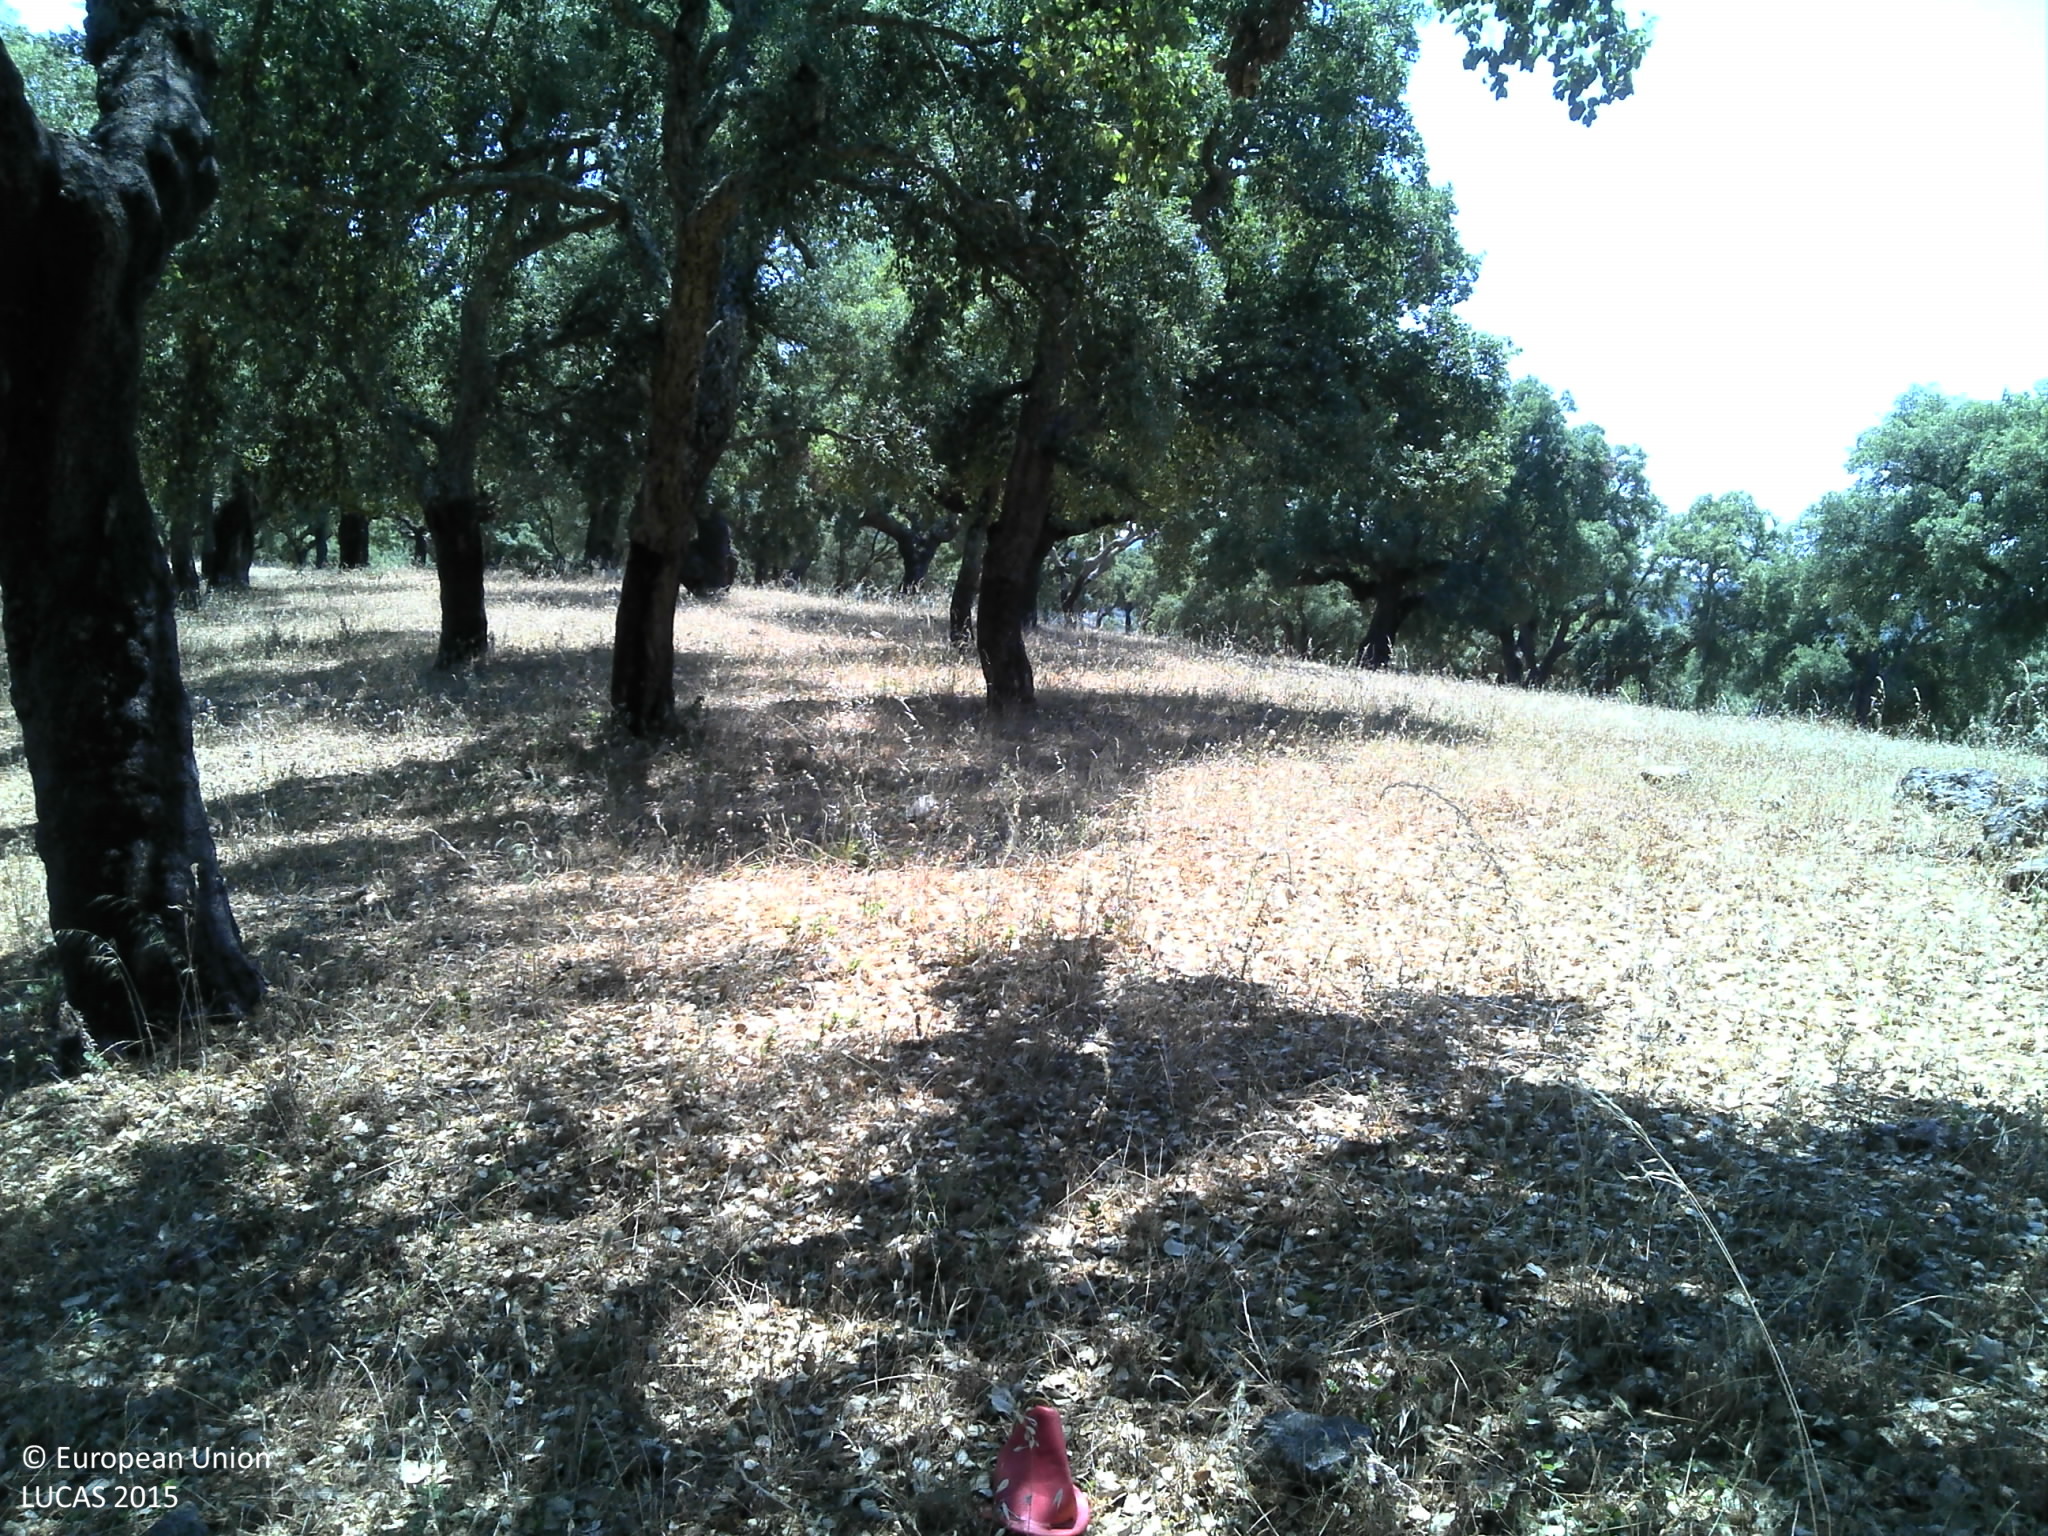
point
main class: Woodland
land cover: Broadleaved woodland
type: broadleaved evergreen forest
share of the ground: 50 - 75 %
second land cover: Grassland without tree/shrub cover
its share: 10 - 25 %
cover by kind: broadleaved forest trees 75 %, unconsolidated bare surface 15 %, herbaceous plants 10 %
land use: Forestry
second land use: Agriculture (excluding fallow land and kitchen gardens)
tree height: > 5 m
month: June
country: PT
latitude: 38.6124
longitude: -8.1571
